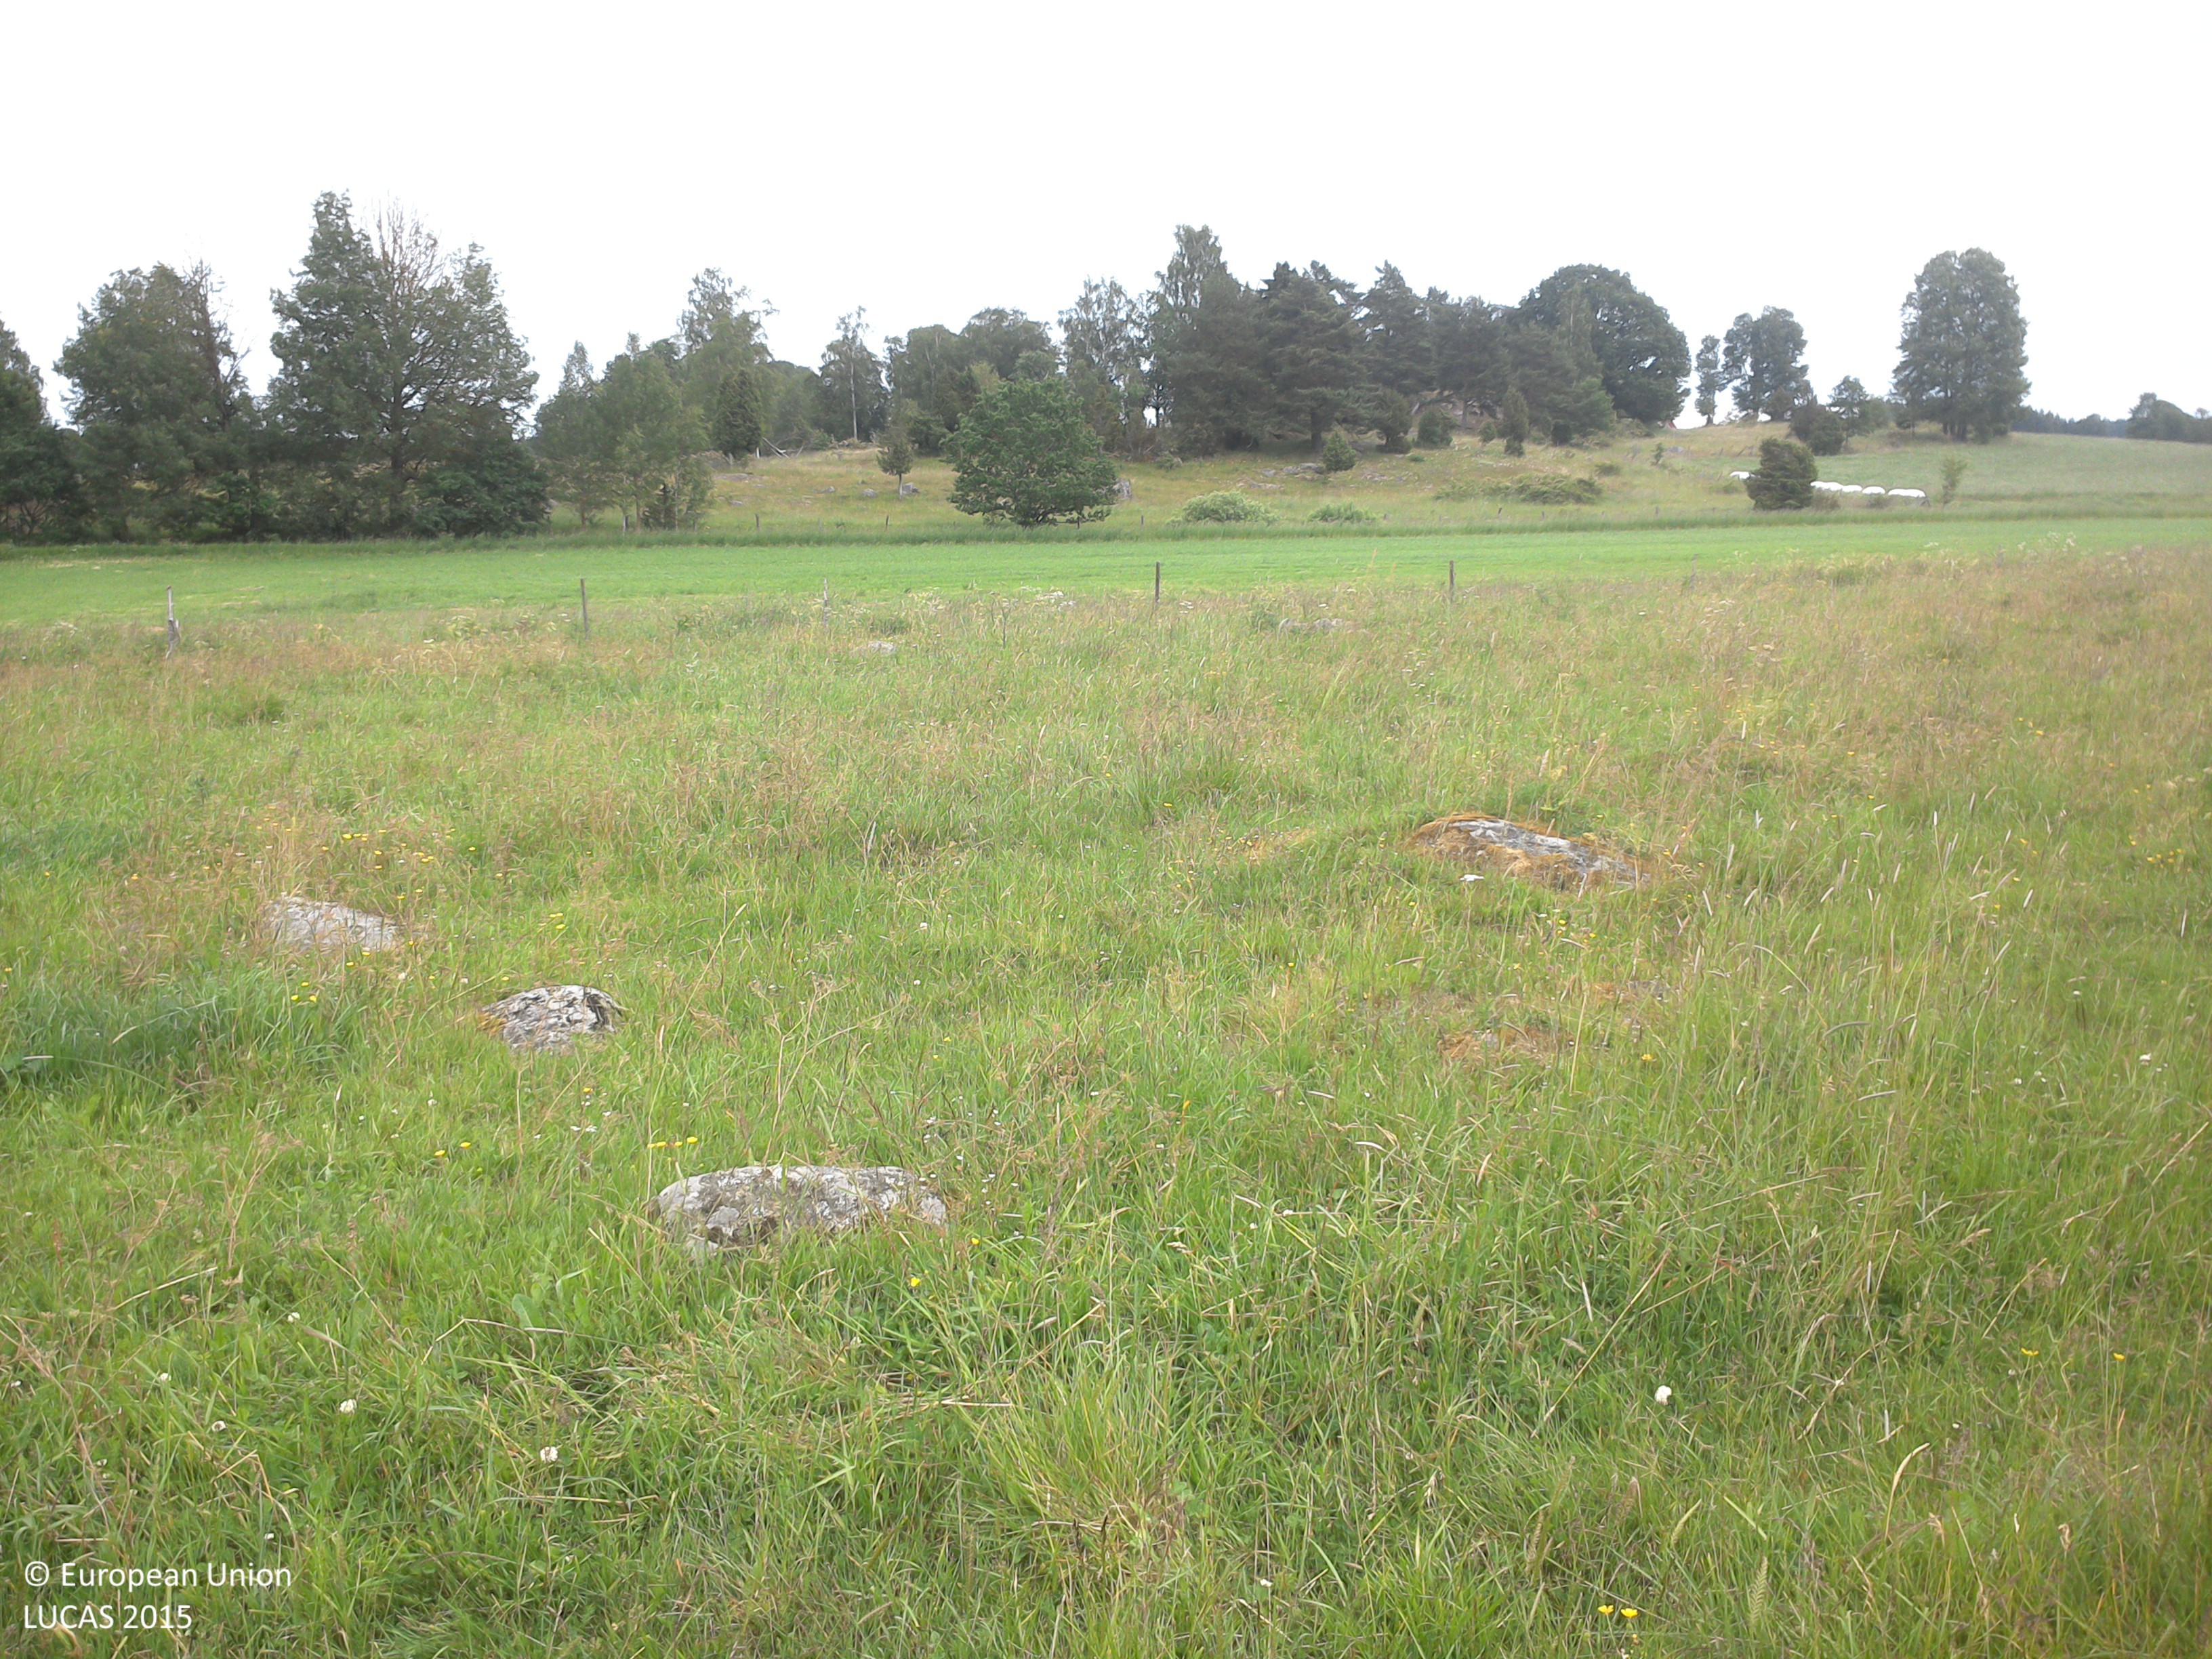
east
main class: Grassland
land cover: Grassland without tree/shrub cover
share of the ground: > 75 %
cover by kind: herbaceous plants 100 %
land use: Agriculture (excluding fallow land and kitchen gardens)
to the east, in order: Grassland without tree/shrub cover; Electric lines; Grassland with sparse tree/shrub cover; Fences; Grassland without tree/shrub cover; Grass margins; Ditches and canals; Fences; Grassland with sparse tree/shrub cover; Pine dominated coniferous woodland
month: June
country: SE
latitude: 58.3065
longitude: 15.4726
